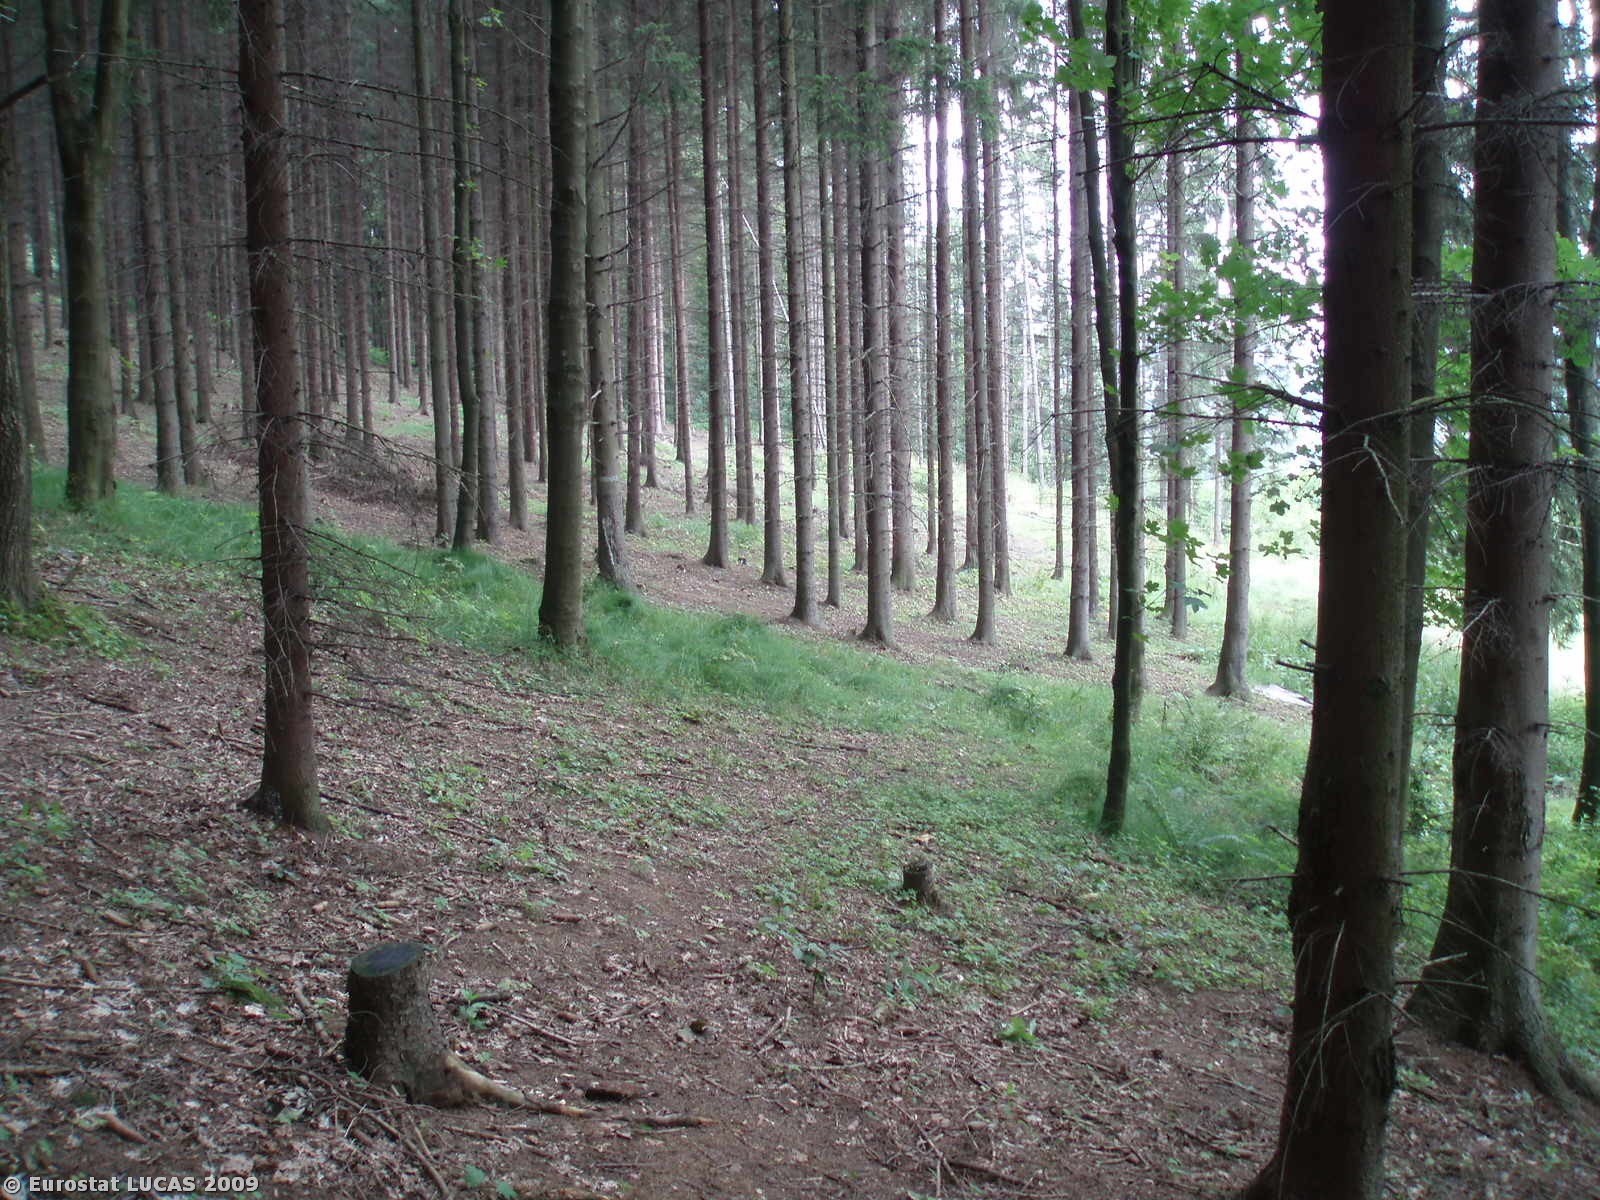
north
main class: Woodland
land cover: Coniferous woodland
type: hemiboreal forest and nemoral coniferous forest and mixed broadleaved-coniferous forest
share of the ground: > 75 %
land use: Forestry
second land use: Nature reserves
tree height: > 5 m
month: July
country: CZ
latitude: 50.7972
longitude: 14.9543
